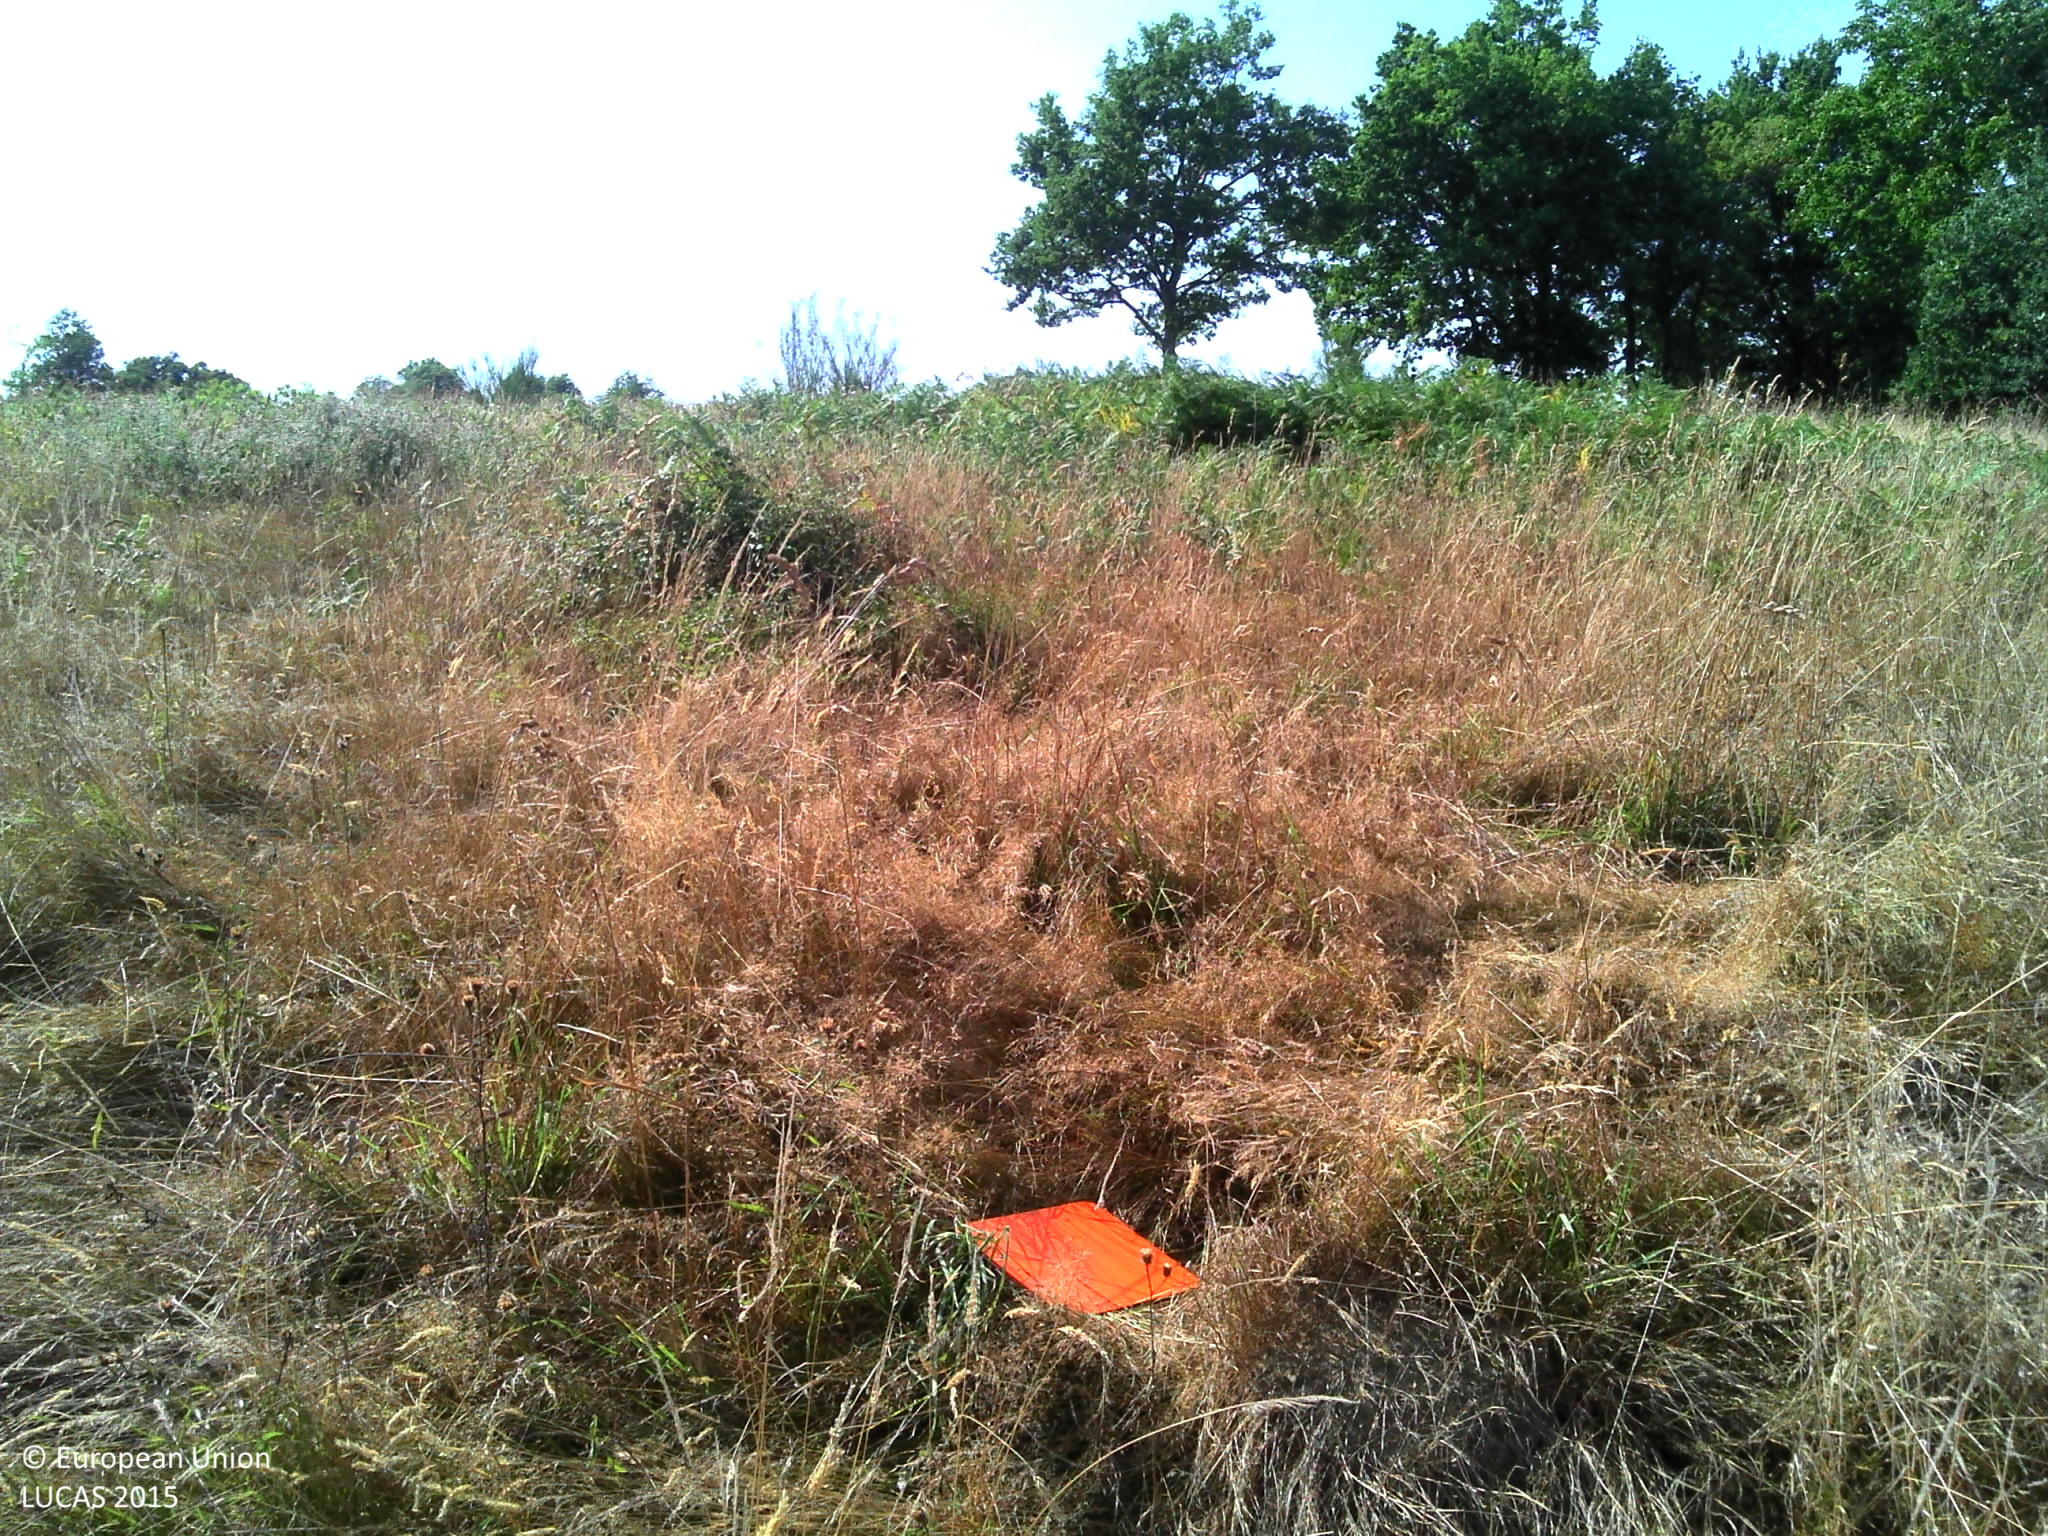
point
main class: Grassland
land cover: Grassland without tree/shrub cover
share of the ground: > 75 %
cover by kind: herbaceous plants 95 %, lichens and mosses 5 %
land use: Agriculture (excluding fallow land and kitchen gardens)
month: August
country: FR
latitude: 45.4123
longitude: 1.0339
